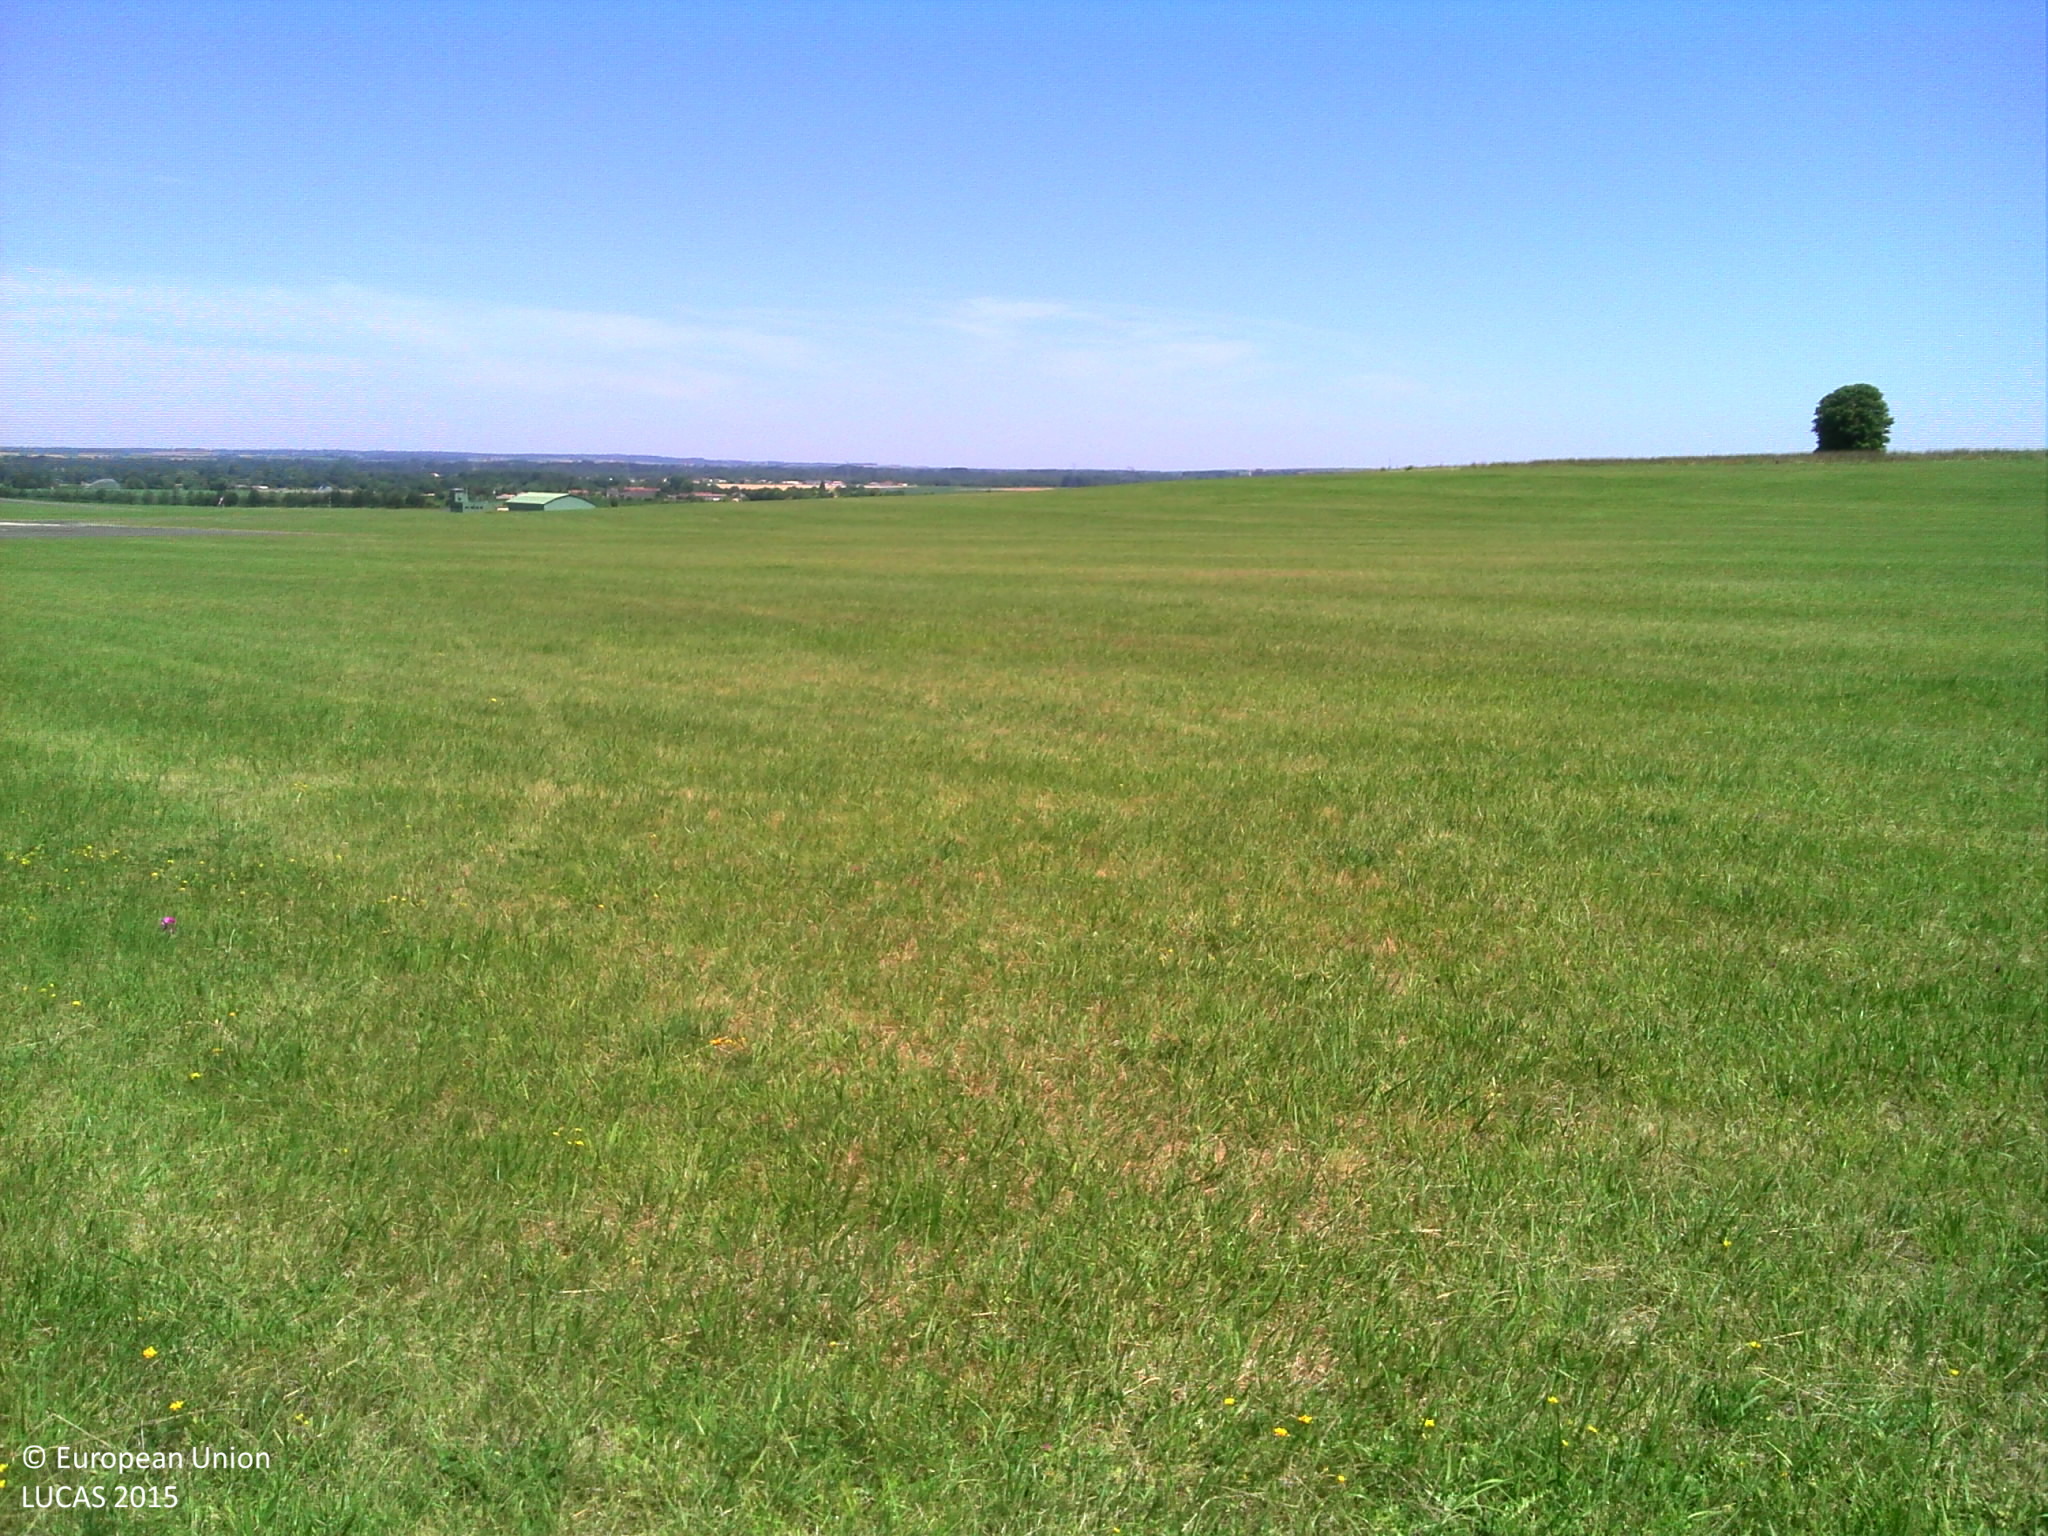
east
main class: Grassland
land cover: Grassland without tree/shrub cover
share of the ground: > 75 %
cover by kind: herbaceous plants 100 %
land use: Air transport
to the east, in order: Grassland without tree/shrub cover
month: June
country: FR
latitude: 45.6915
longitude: -0.6437
